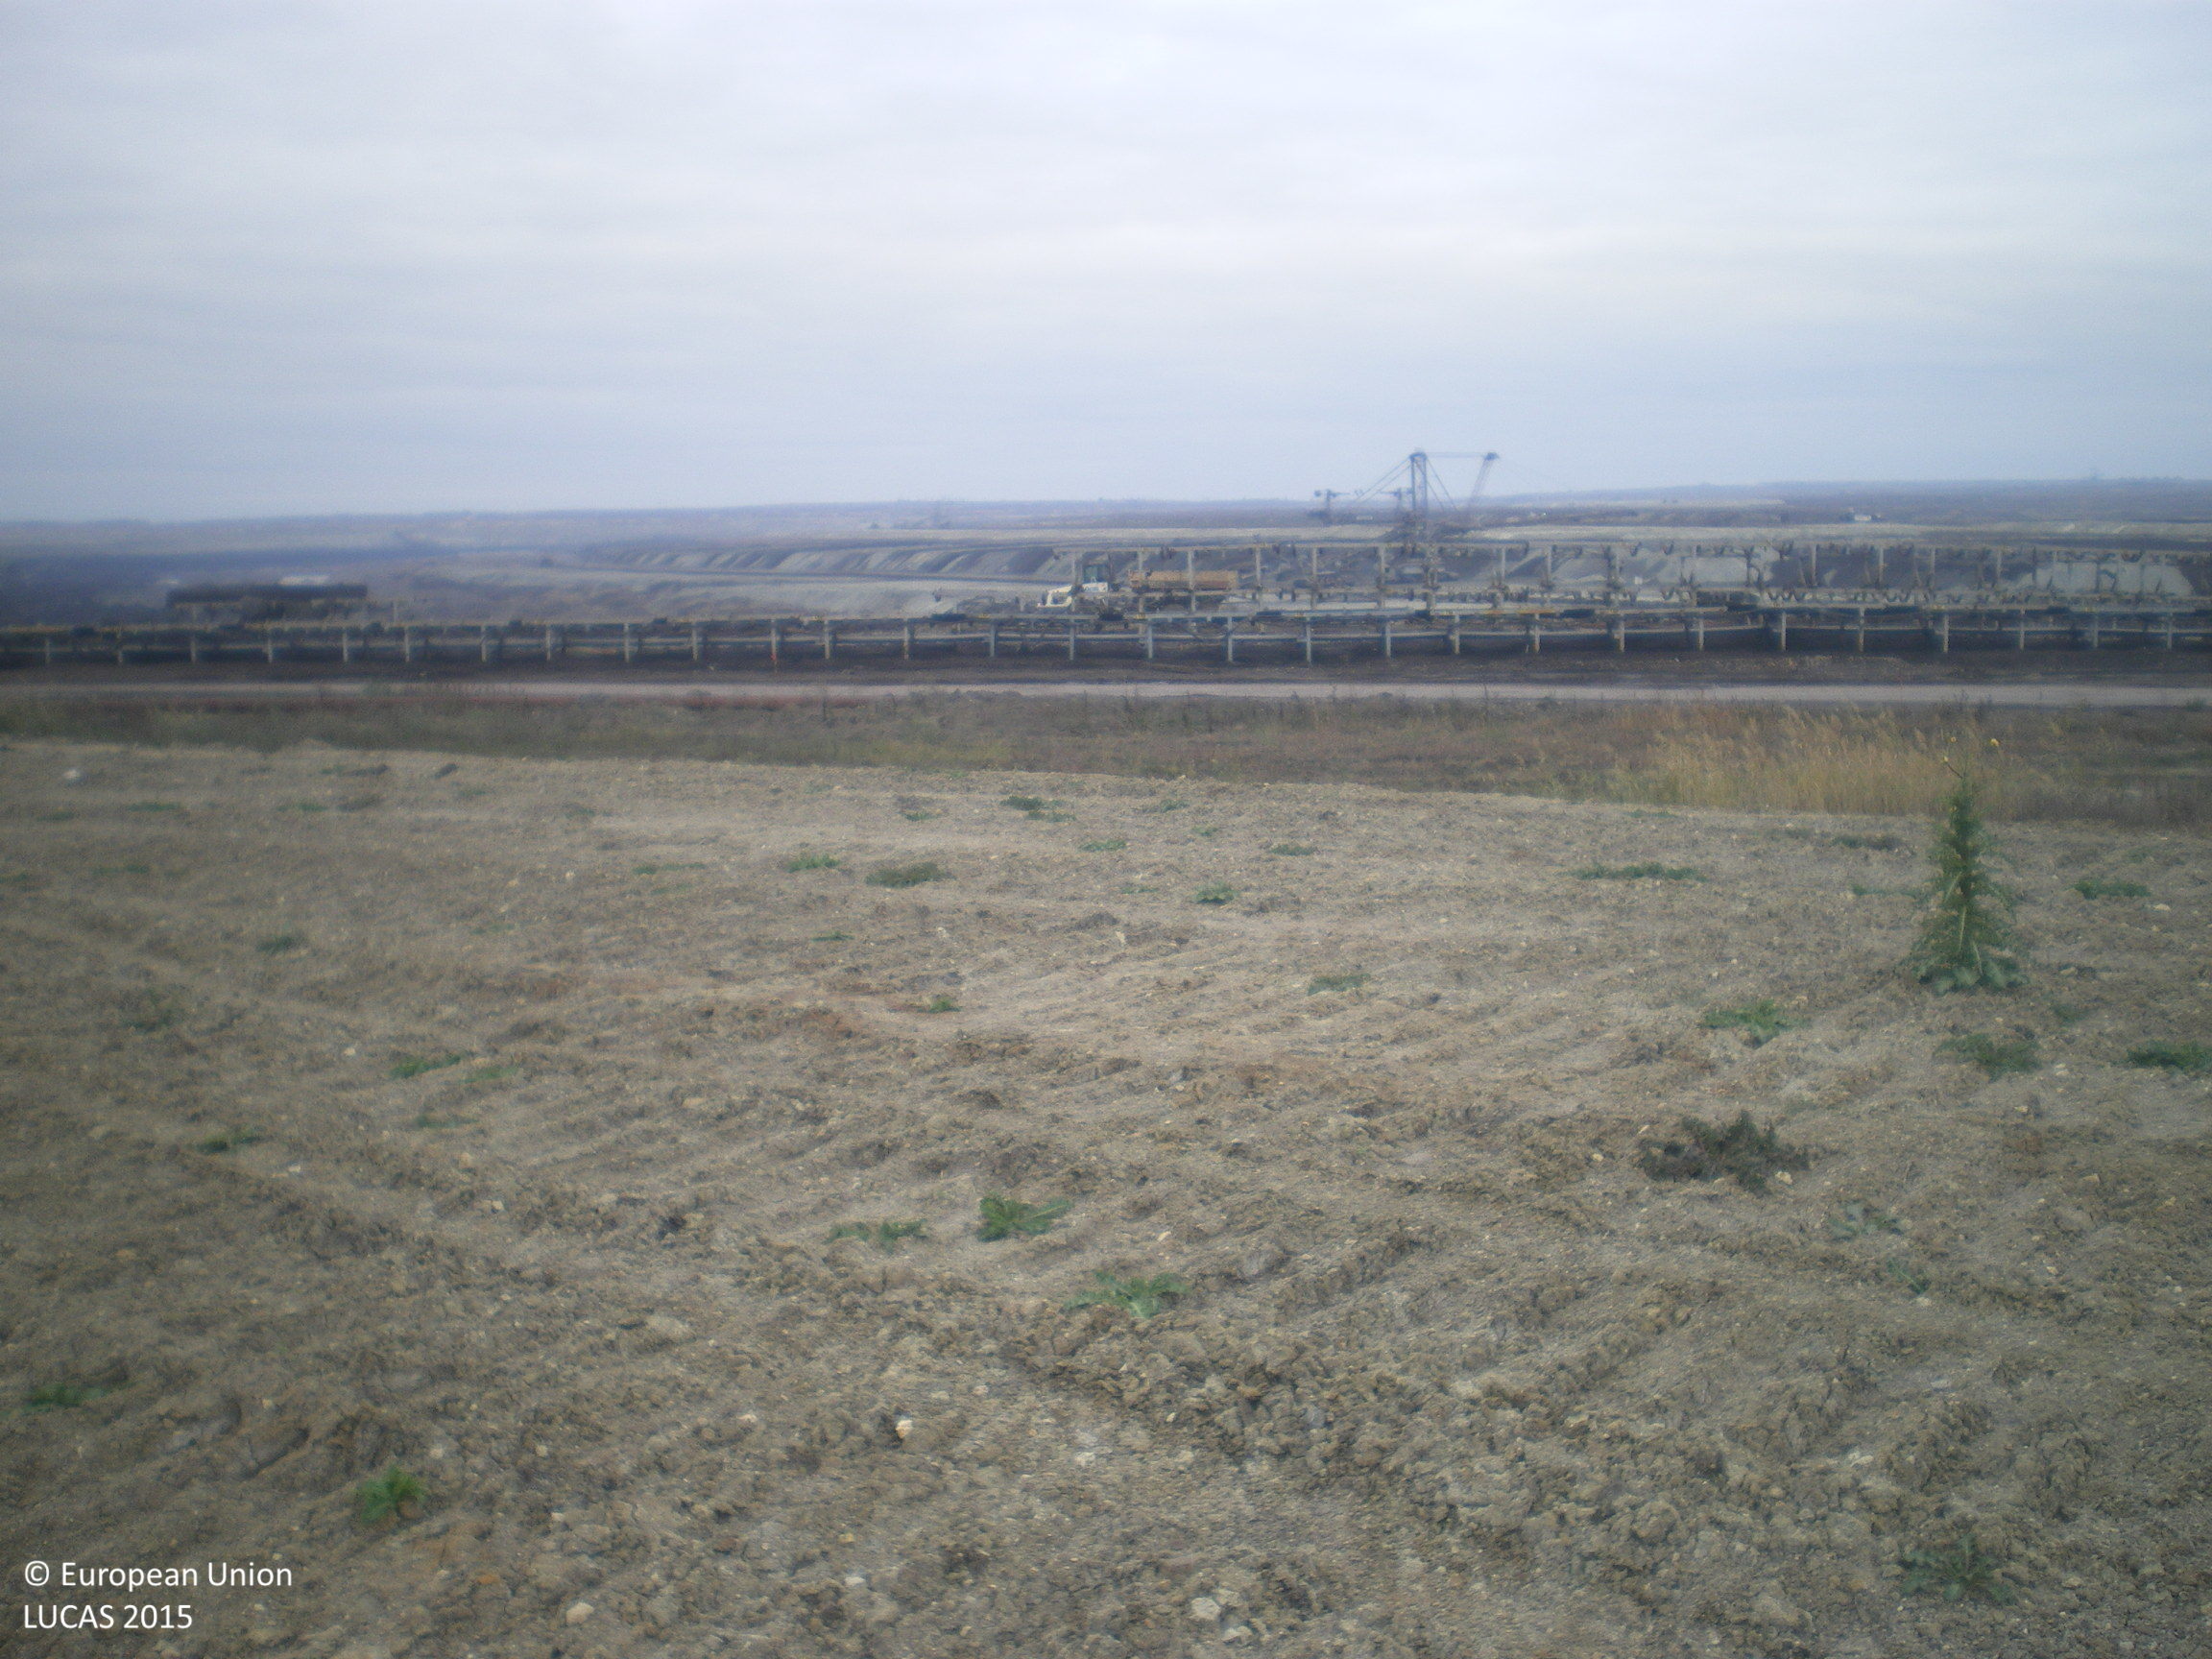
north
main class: Grassland
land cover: Grassland without tree/shrub cover
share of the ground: > 75 %
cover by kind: herbaceous plants 100 %
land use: Mining and quarrying
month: October
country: BG
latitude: 42.1989
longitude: 26.0025
